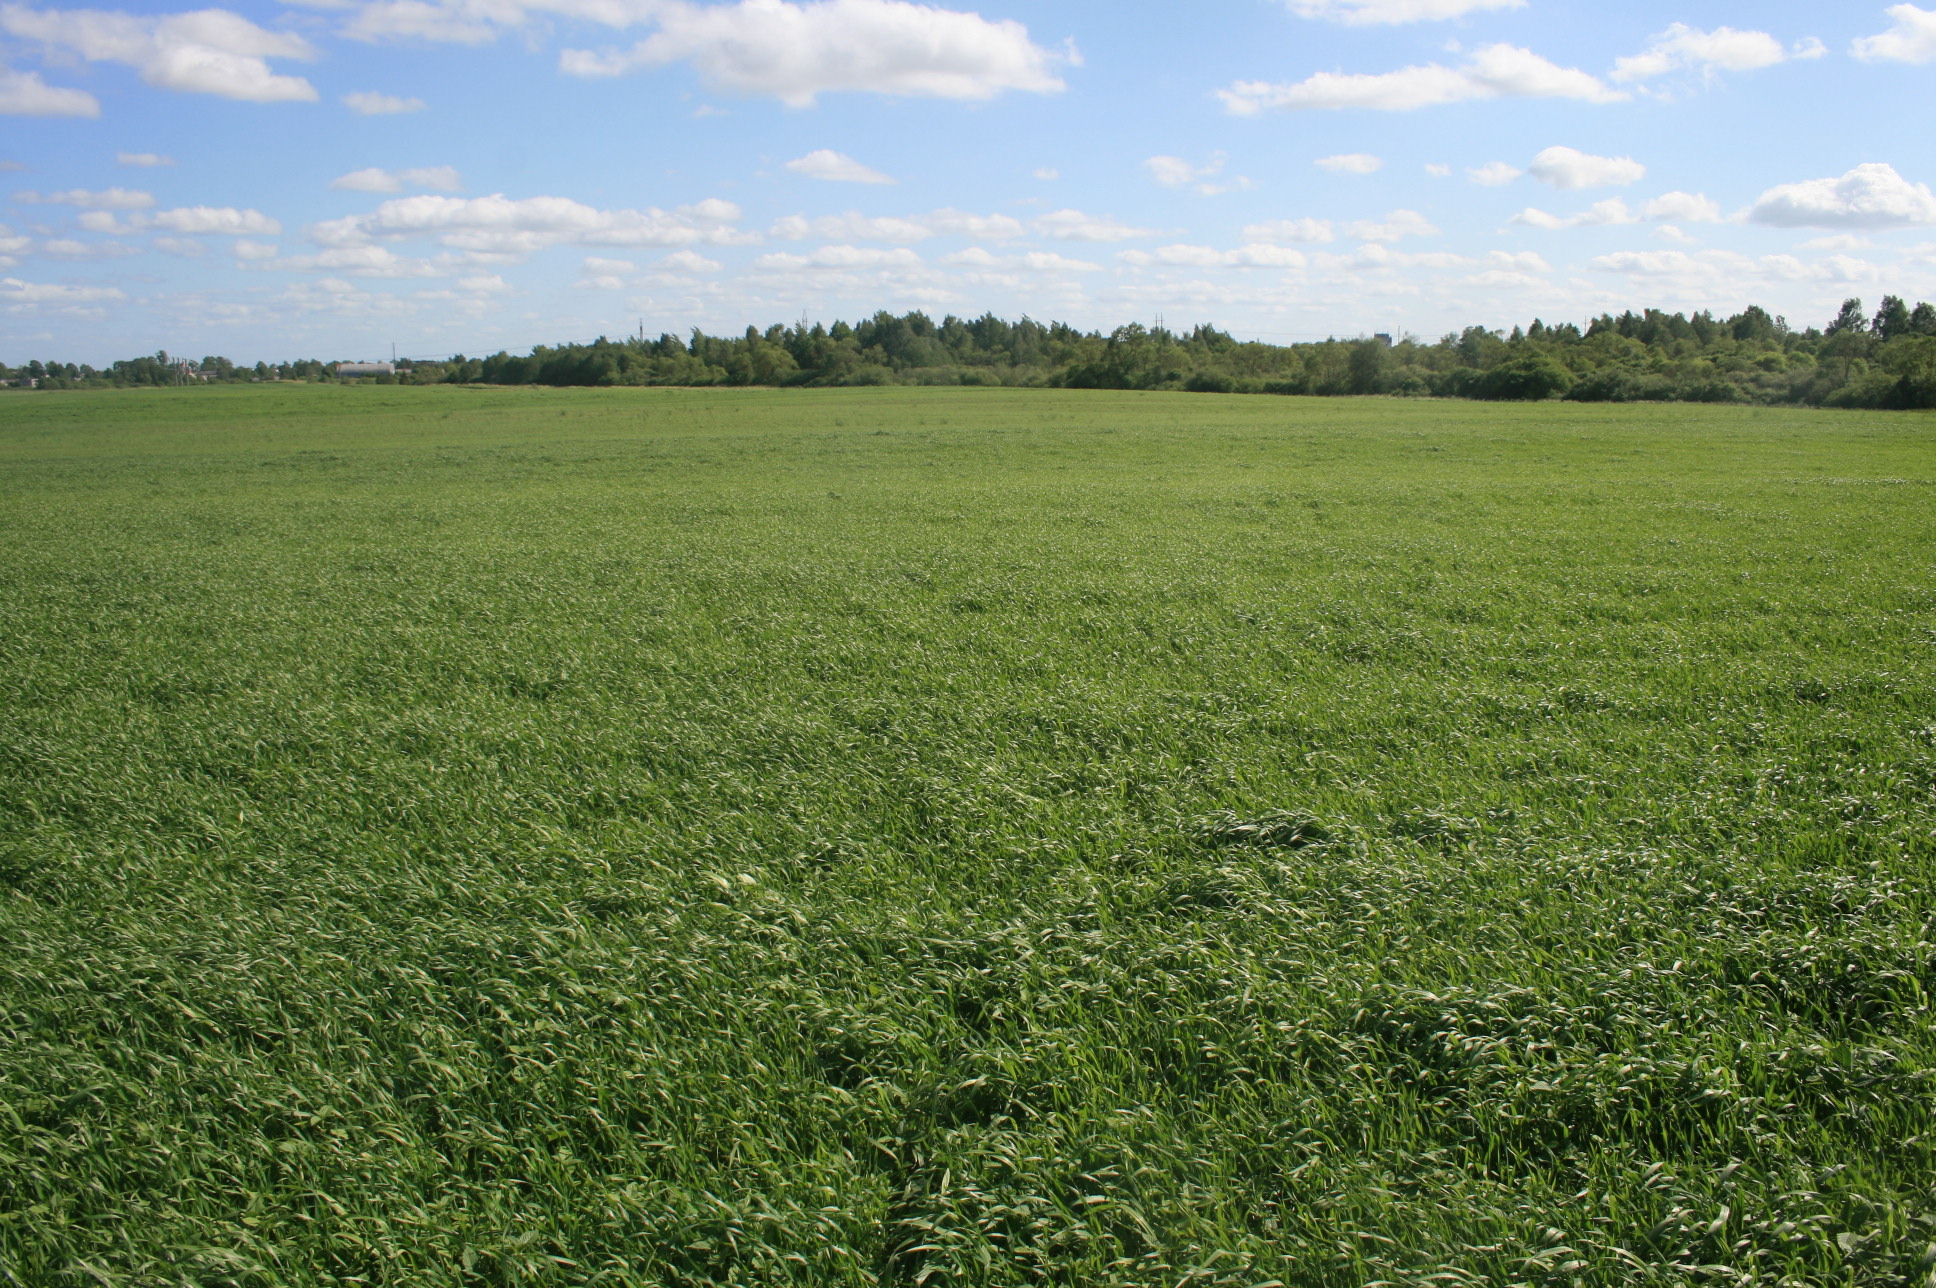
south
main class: Cropland
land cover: Common wheat
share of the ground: > 75 %
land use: Agriculture (excluding fallow land and kitchen gardens)
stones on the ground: < 10 %
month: June
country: LT
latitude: 56.0242
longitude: 22.3632
